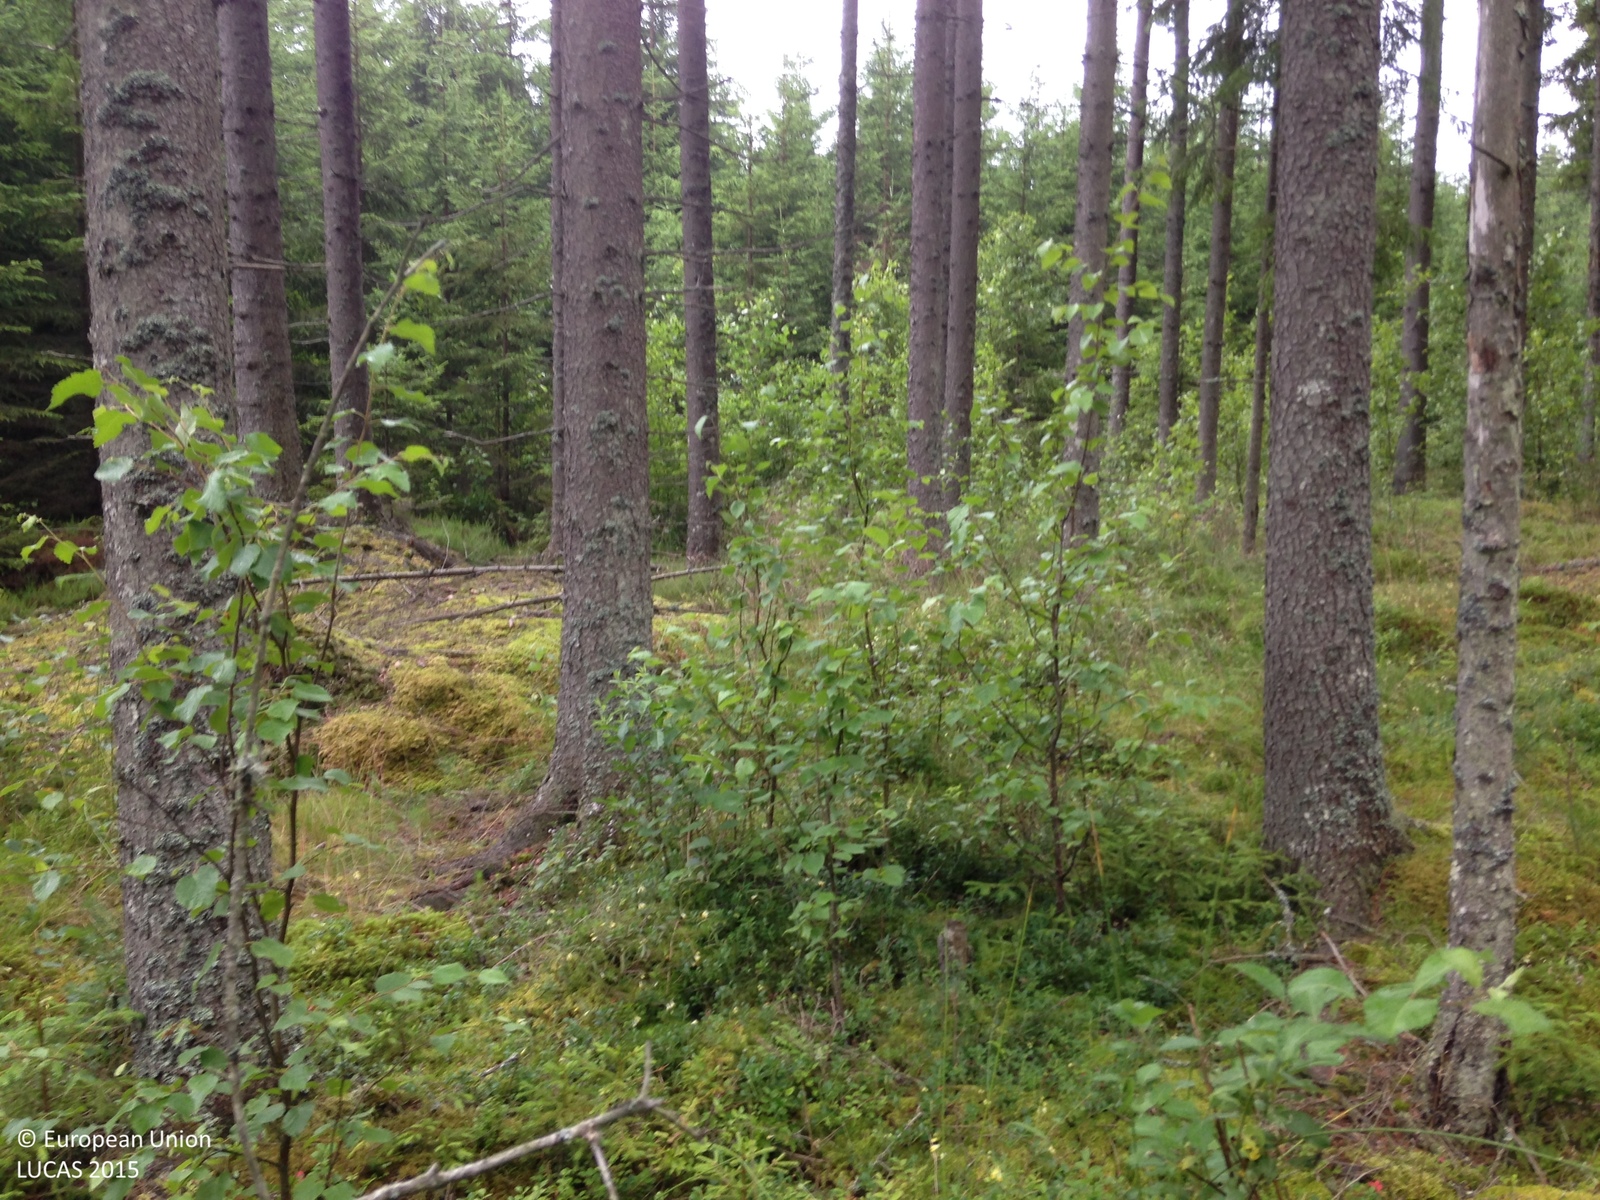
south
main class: Woodland
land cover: Spruce dominated coniferous woodland
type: boreal forest
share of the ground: 25 - 50 %
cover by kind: coniferous forest trees 35 %, herbaceous plants 30 %, lichens and mosses 20 %, shrubs 10 %, broadleaved forest trees 5 %
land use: Forestry
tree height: > 5 m
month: July
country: SE
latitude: 59.0809
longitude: 14.5112
